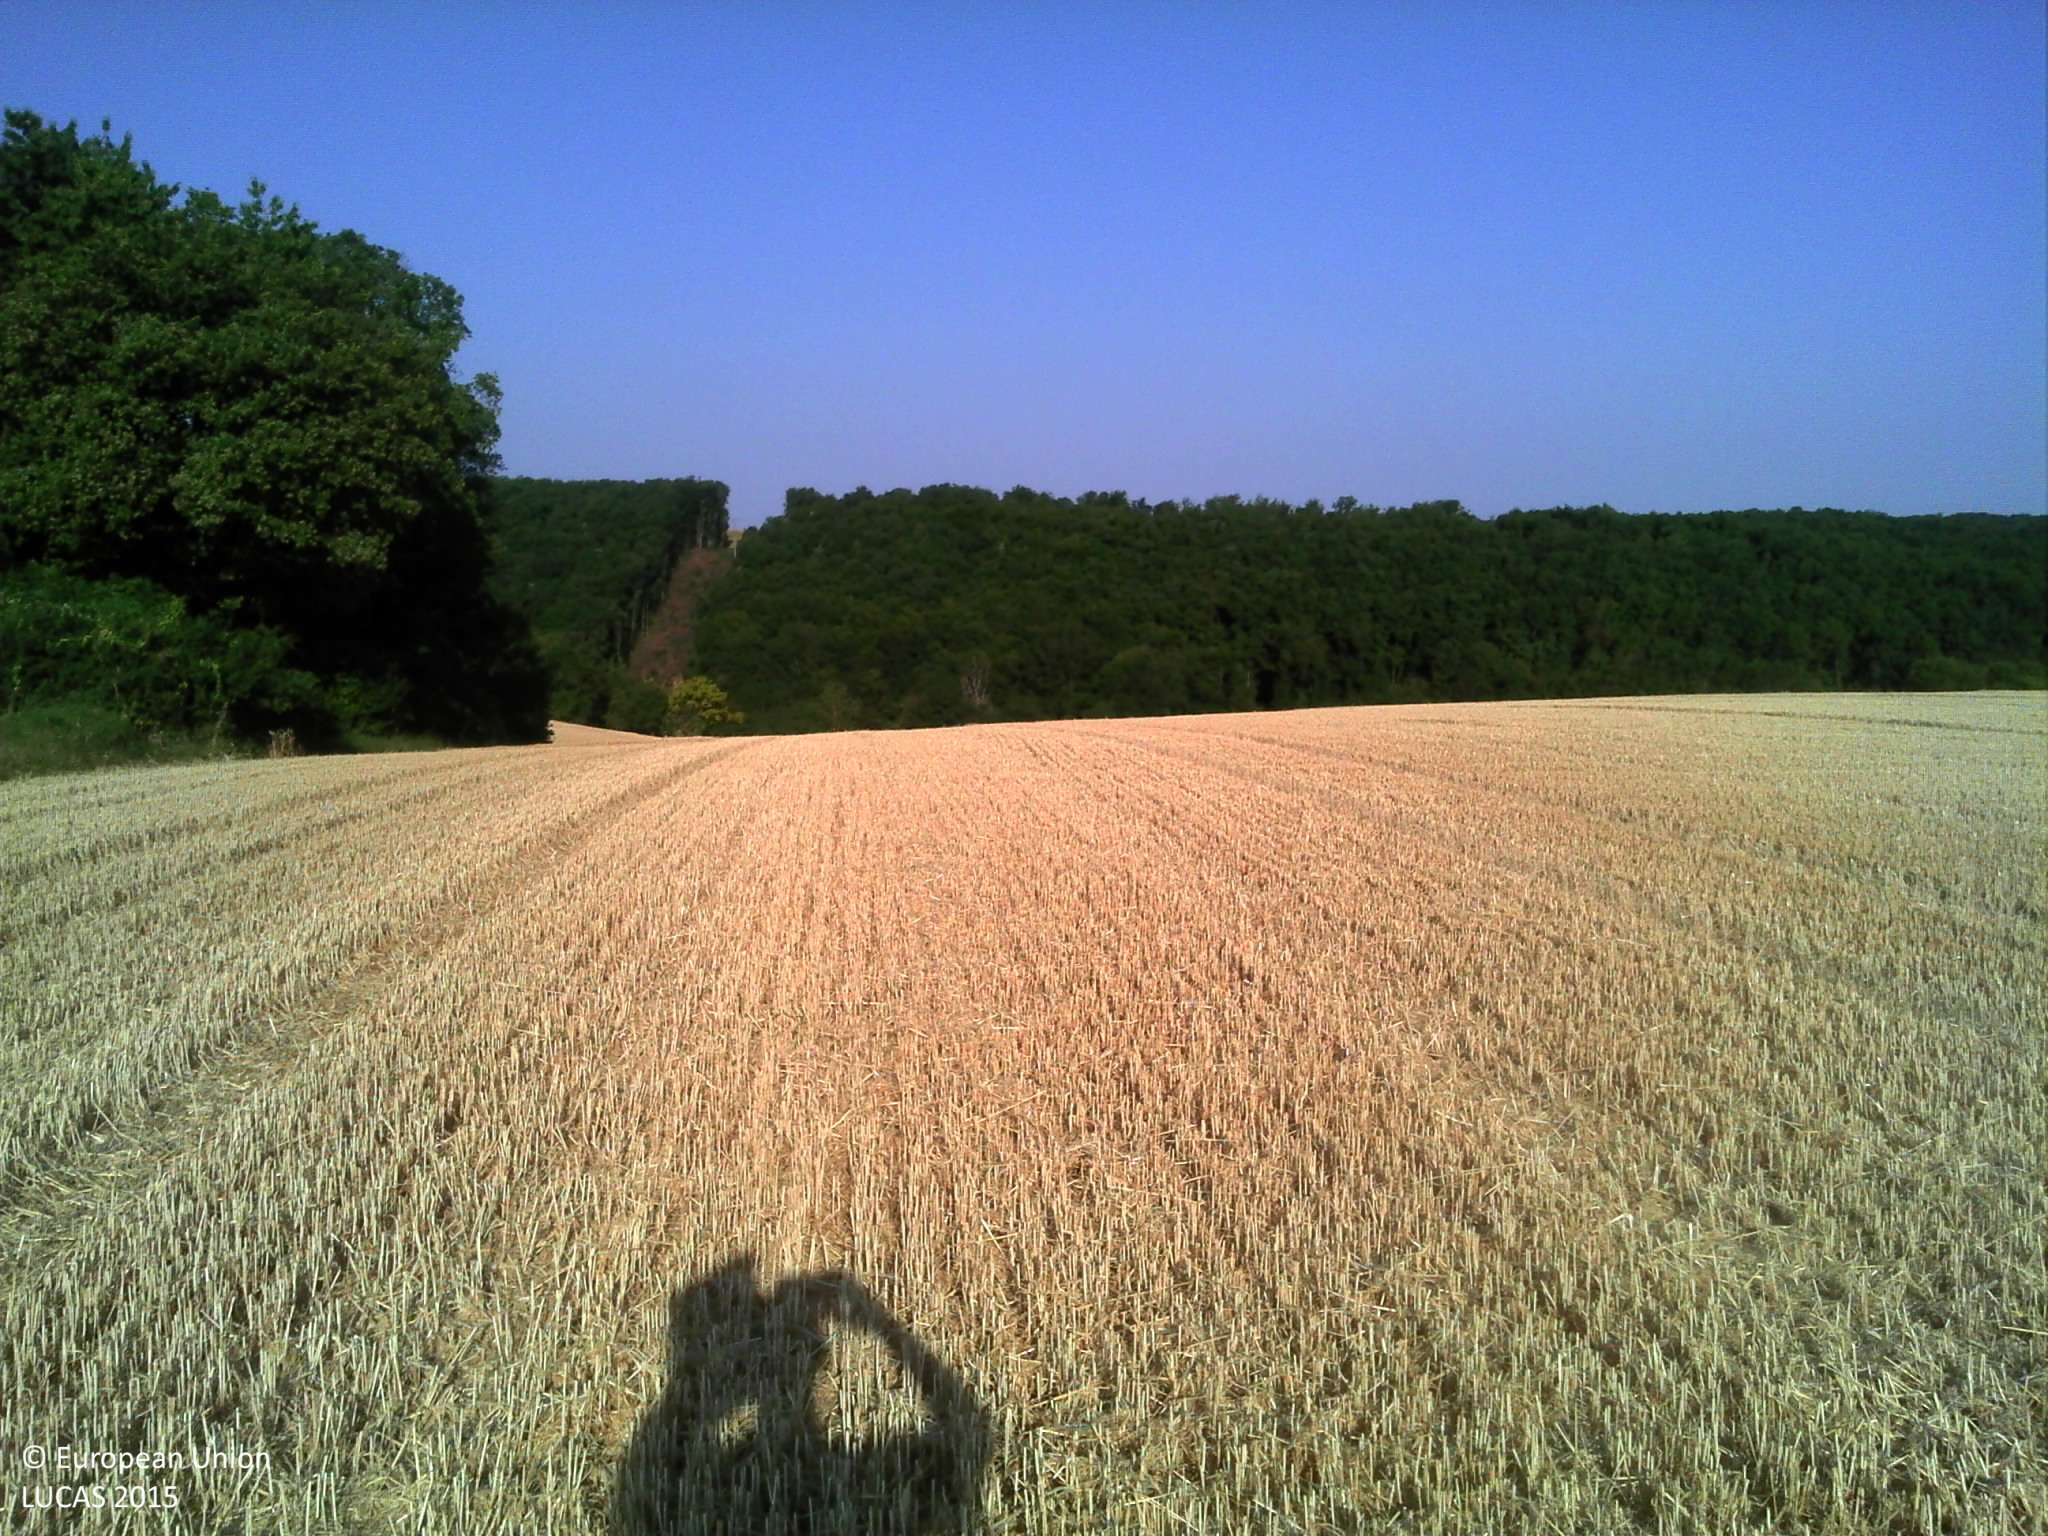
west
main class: Cropland
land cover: Common wheat
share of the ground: > 75 %
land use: Agriculture (excluding fallow land and kitchen gardens)
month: July
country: FR
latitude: 47.6859
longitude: 3.4544
